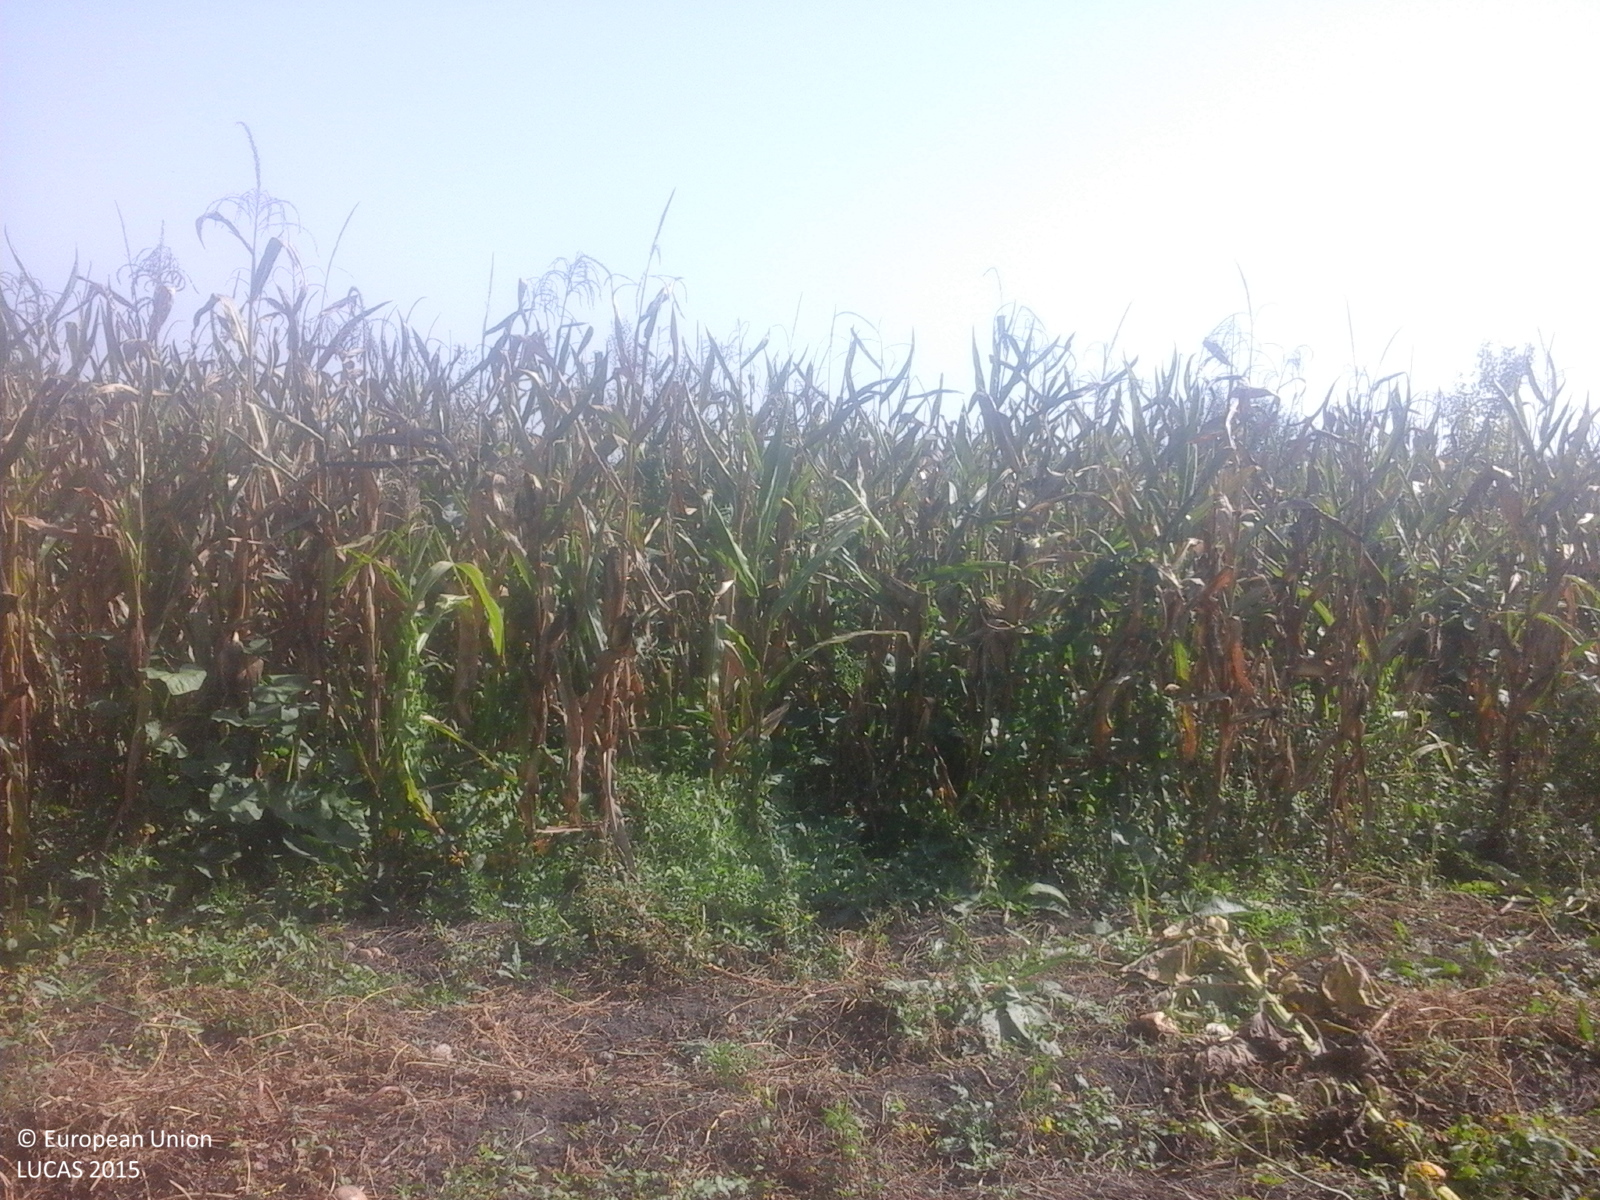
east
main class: Cropland
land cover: Potatoes
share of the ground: 50 - 75 %
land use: Agriculture (excluding fallow land and kitchen gardens)
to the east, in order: Potatoes; Maize; Abandoned hedges; Ditches and canals; Grassland without tree/shrub cover; Ditches and canals; Grassland without tree/shrub cover
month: September
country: RO
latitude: 46.7957
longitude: 24.4067
